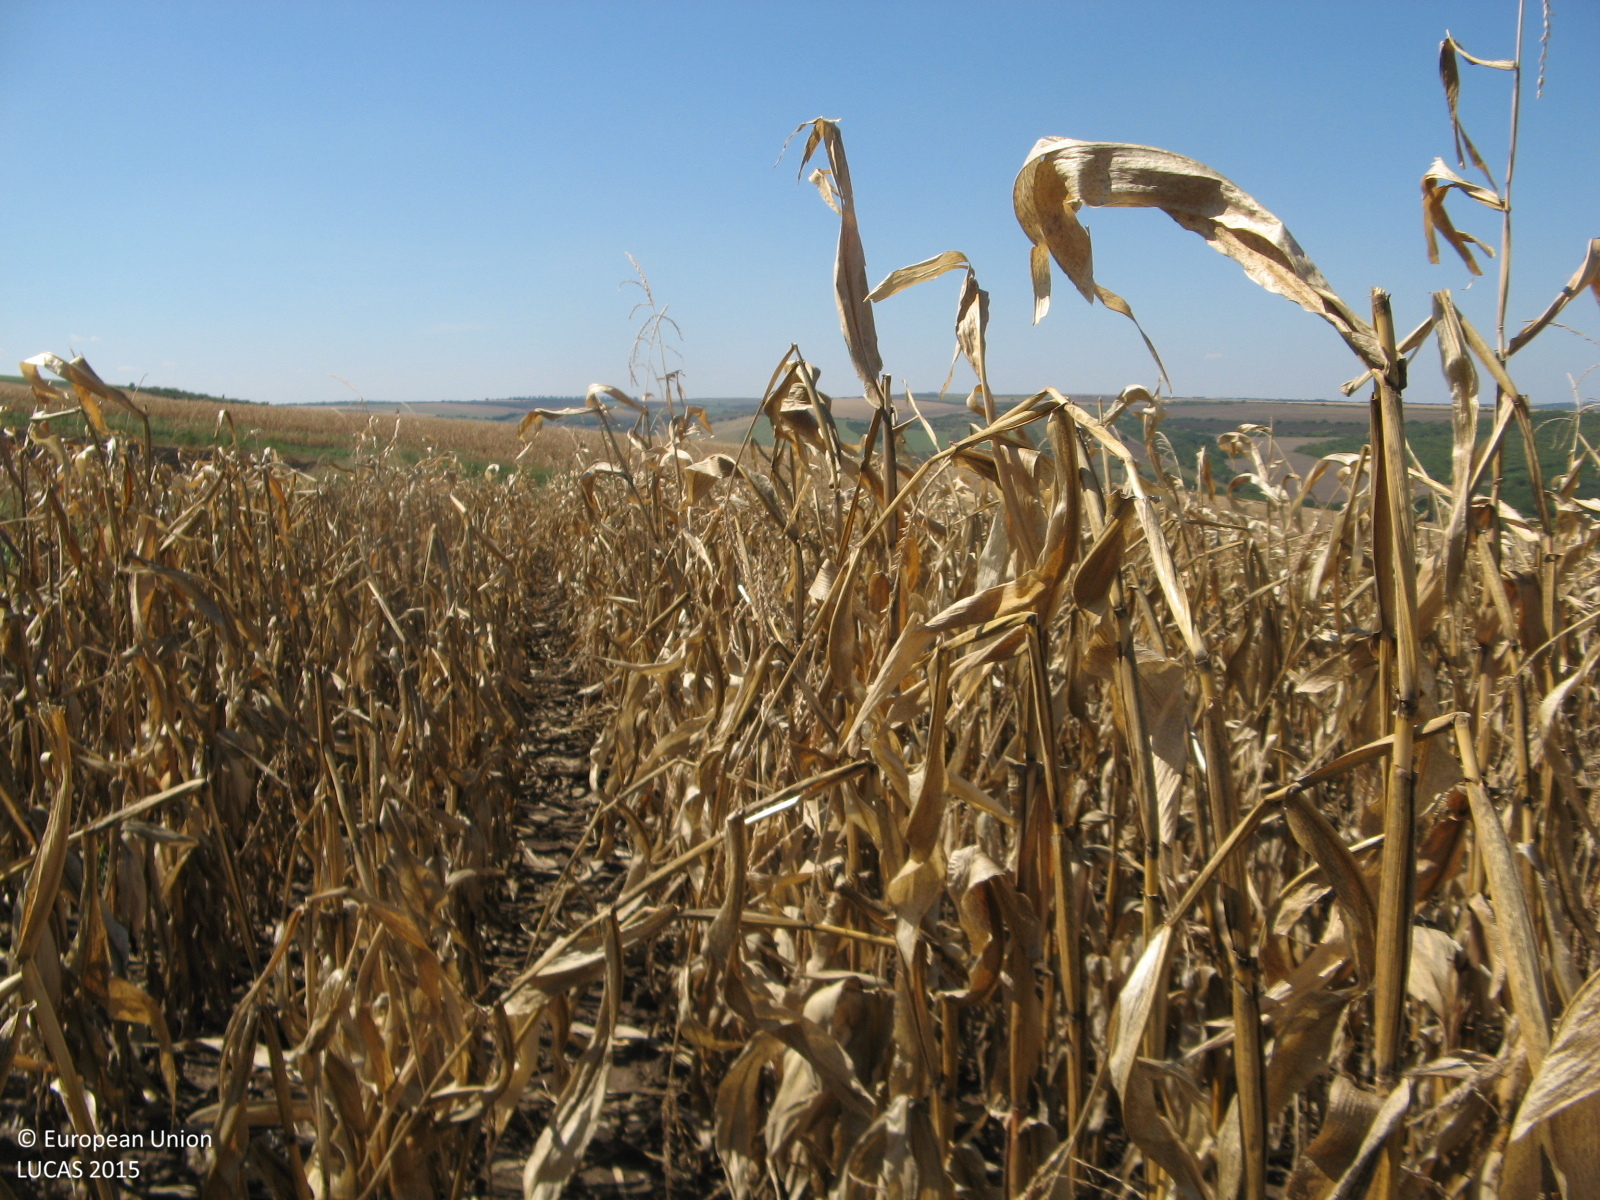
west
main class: Cropland
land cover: Maize
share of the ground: > 75 %
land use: Agriculture (excluding fallow land and kitchen gardens)
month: September
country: BG
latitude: 43.5252
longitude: 25.3843
